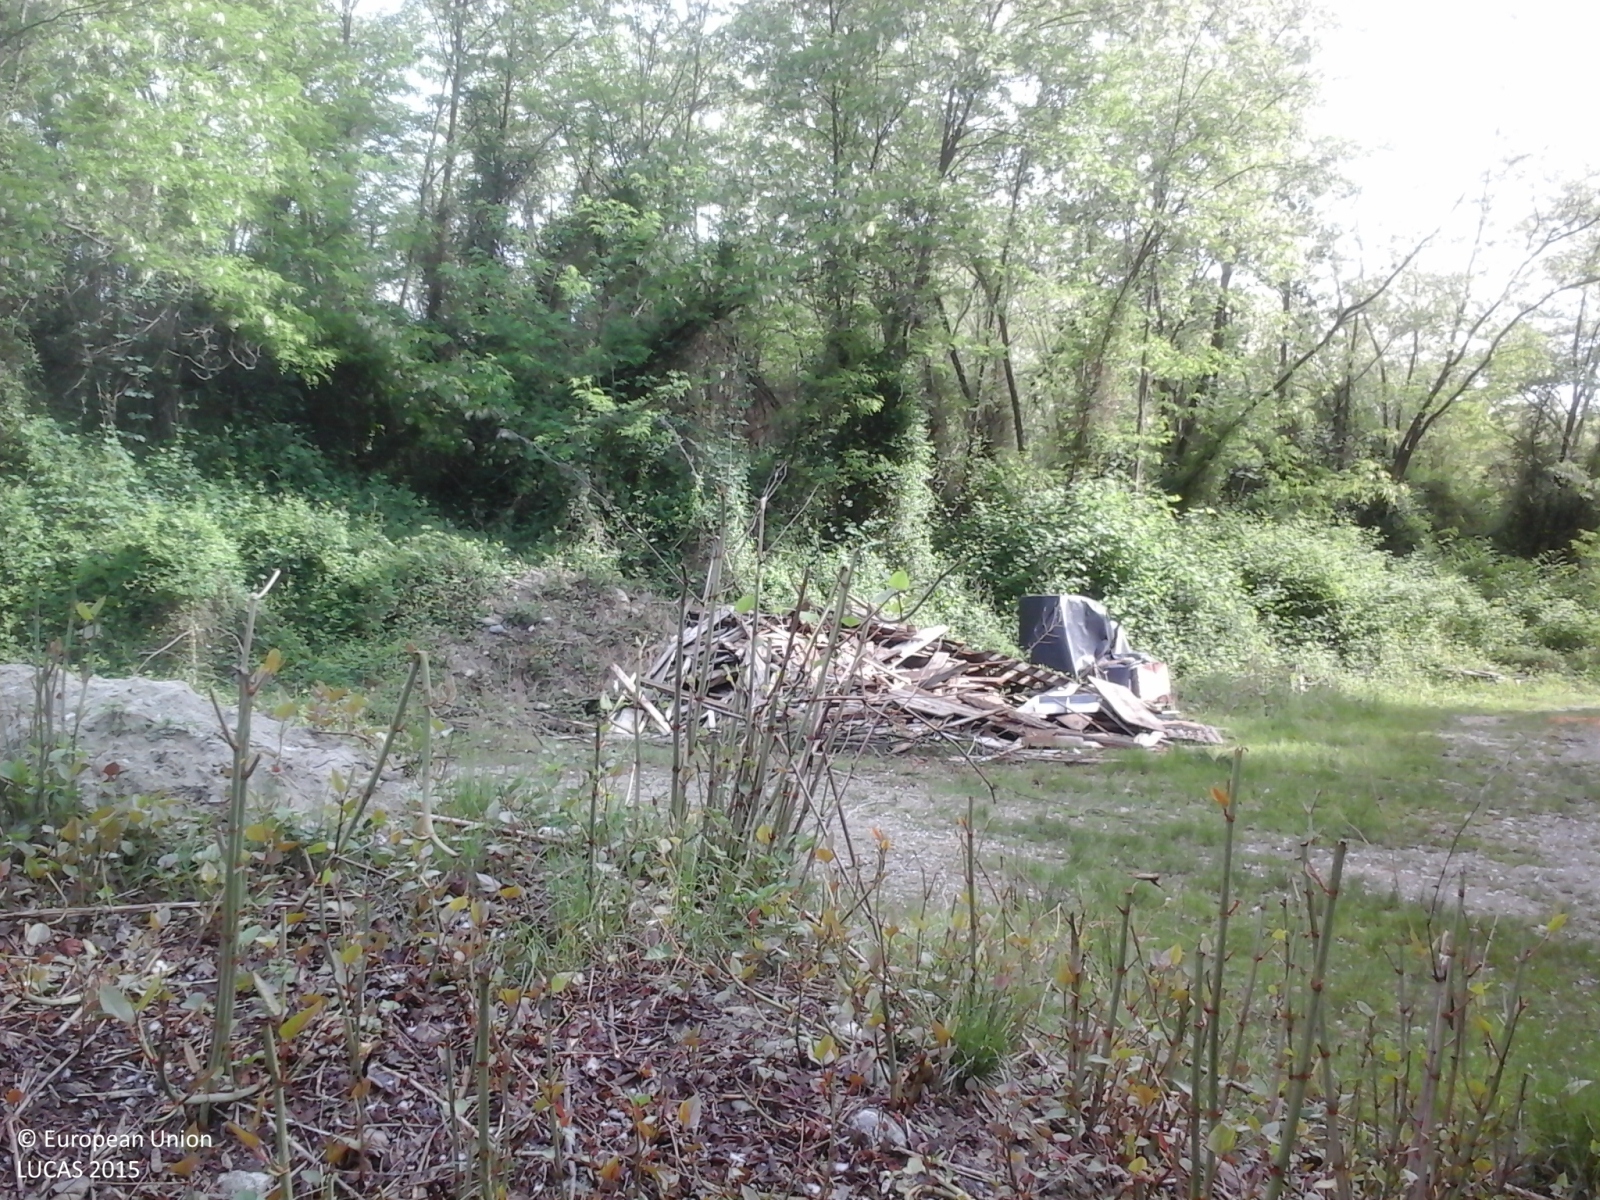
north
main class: Woodland
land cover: Broadleaved woodland
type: non-riverine alder, birch or aspen forest
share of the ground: > 75 %
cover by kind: broadleaved forest trees 100 %
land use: Forestry
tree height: < 5 m
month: May
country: IT
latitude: 45.7069
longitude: 8.2943
